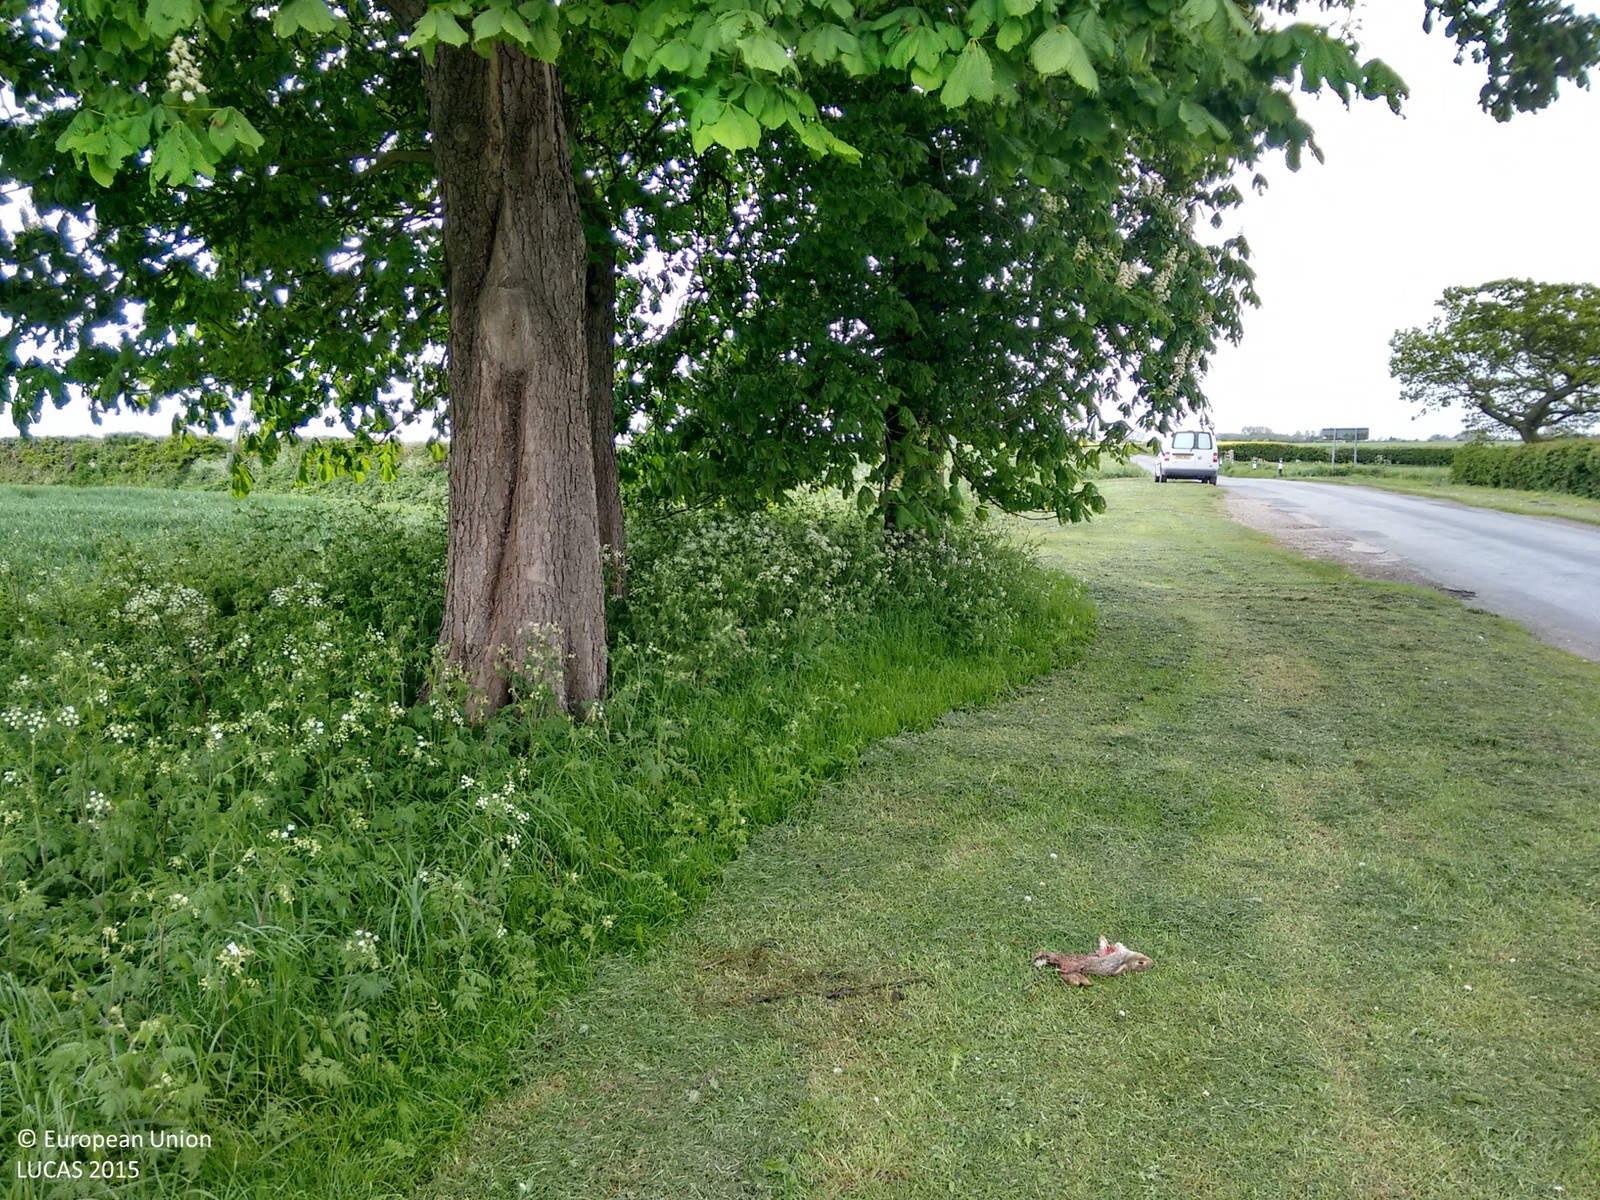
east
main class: Cropland
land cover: Common wheat
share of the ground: > 75 %
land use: Agriculture (excluding fallow land and kitchen gardens)
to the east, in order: Common wheat
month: May
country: GB
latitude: 53.7919
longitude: -0.1274
